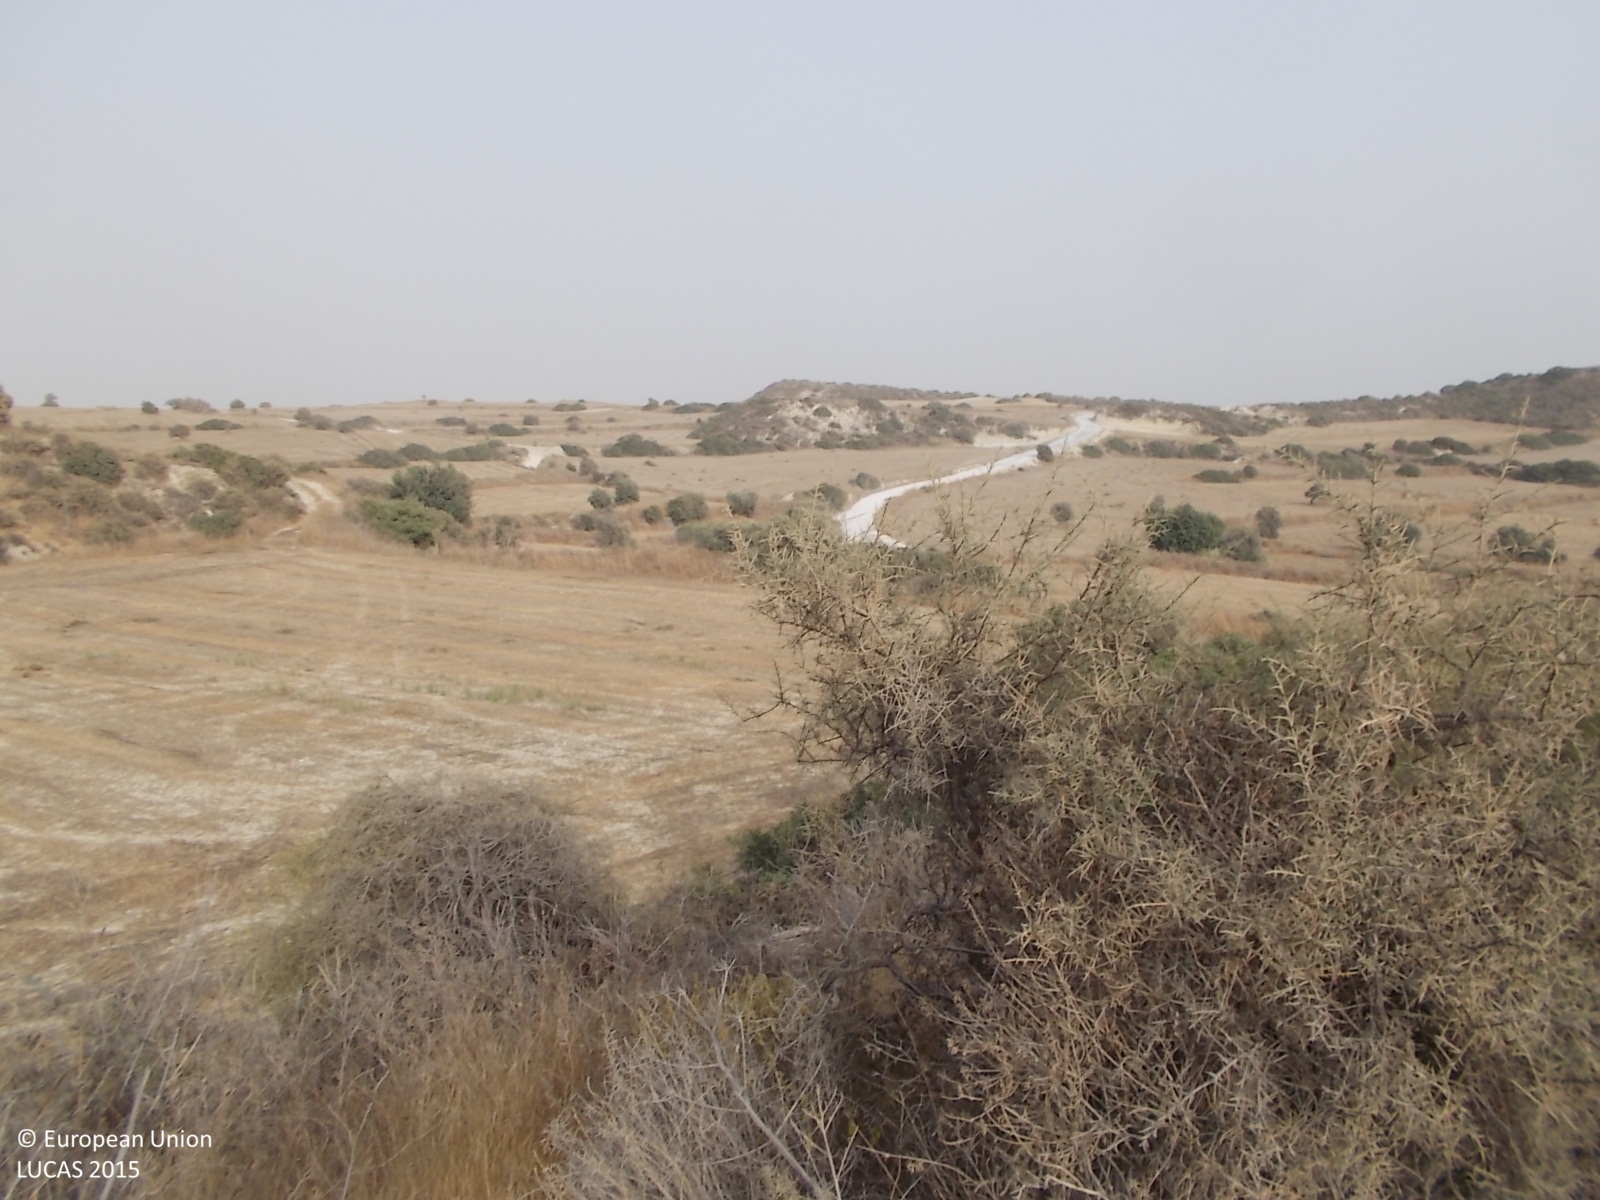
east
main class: Woodland
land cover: Broadleaved woodland
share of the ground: 25 - 50 %
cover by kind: herbaceous plants 60 %, broadleaved forest trees 30 %, unconsolidated bare surface 10 %
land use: Semi-natural and natural areas not in use
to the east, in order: Broadleaved woodland; Barley; Broadleaved woodland; Mixed cereals for fodder; Grassland without tree/shrub cover; Mixed cereals for fodder; Shrubland without tree cover; Mixed cereals for fodder; Olive groves; Mixed cereals for fodder; Grass margins
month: April
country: CY
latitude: 34.8006
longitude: 33.4103
